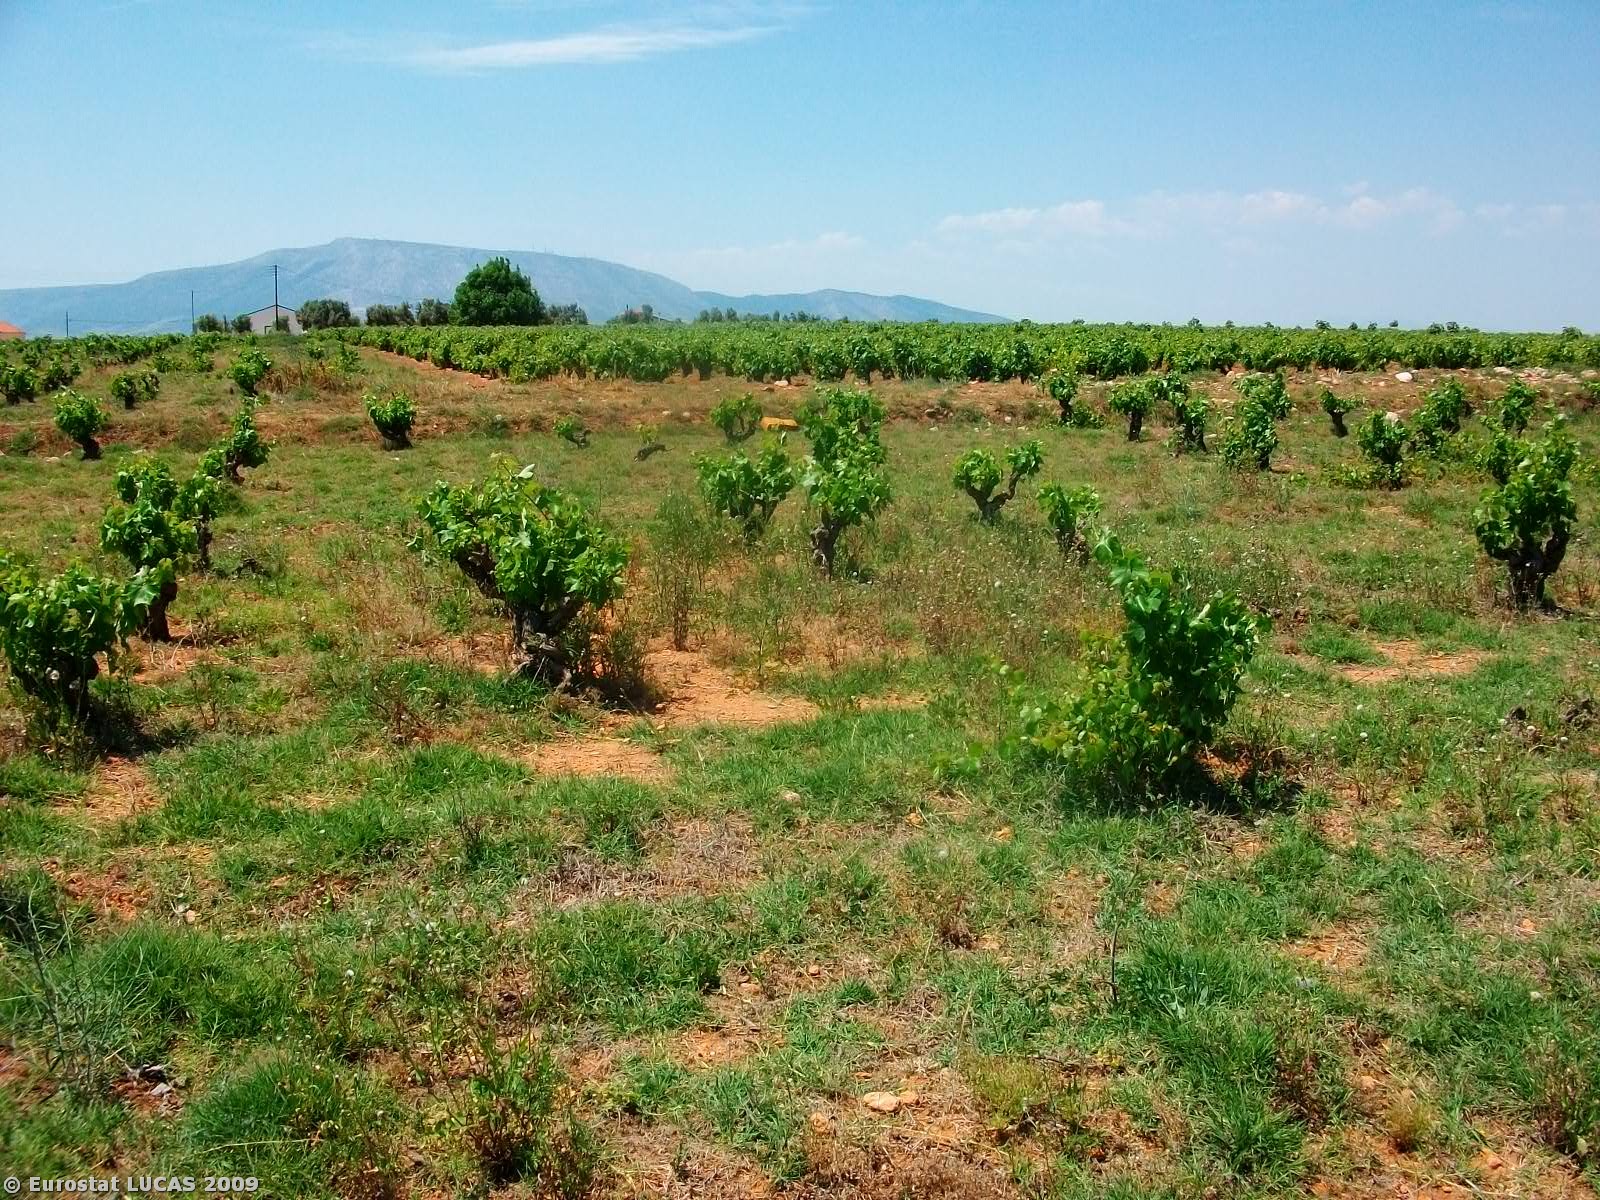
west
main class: Cropland
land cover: Vineyards
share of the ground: 25 - 50 %
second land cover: Grassland with sparse tree/shrub cover
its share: > 75 %
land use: Agriculture (excluding fallow land and kitchen gardens)
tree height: < 5 m
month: May
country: GR
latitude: 37.9095
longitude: 23.9375
